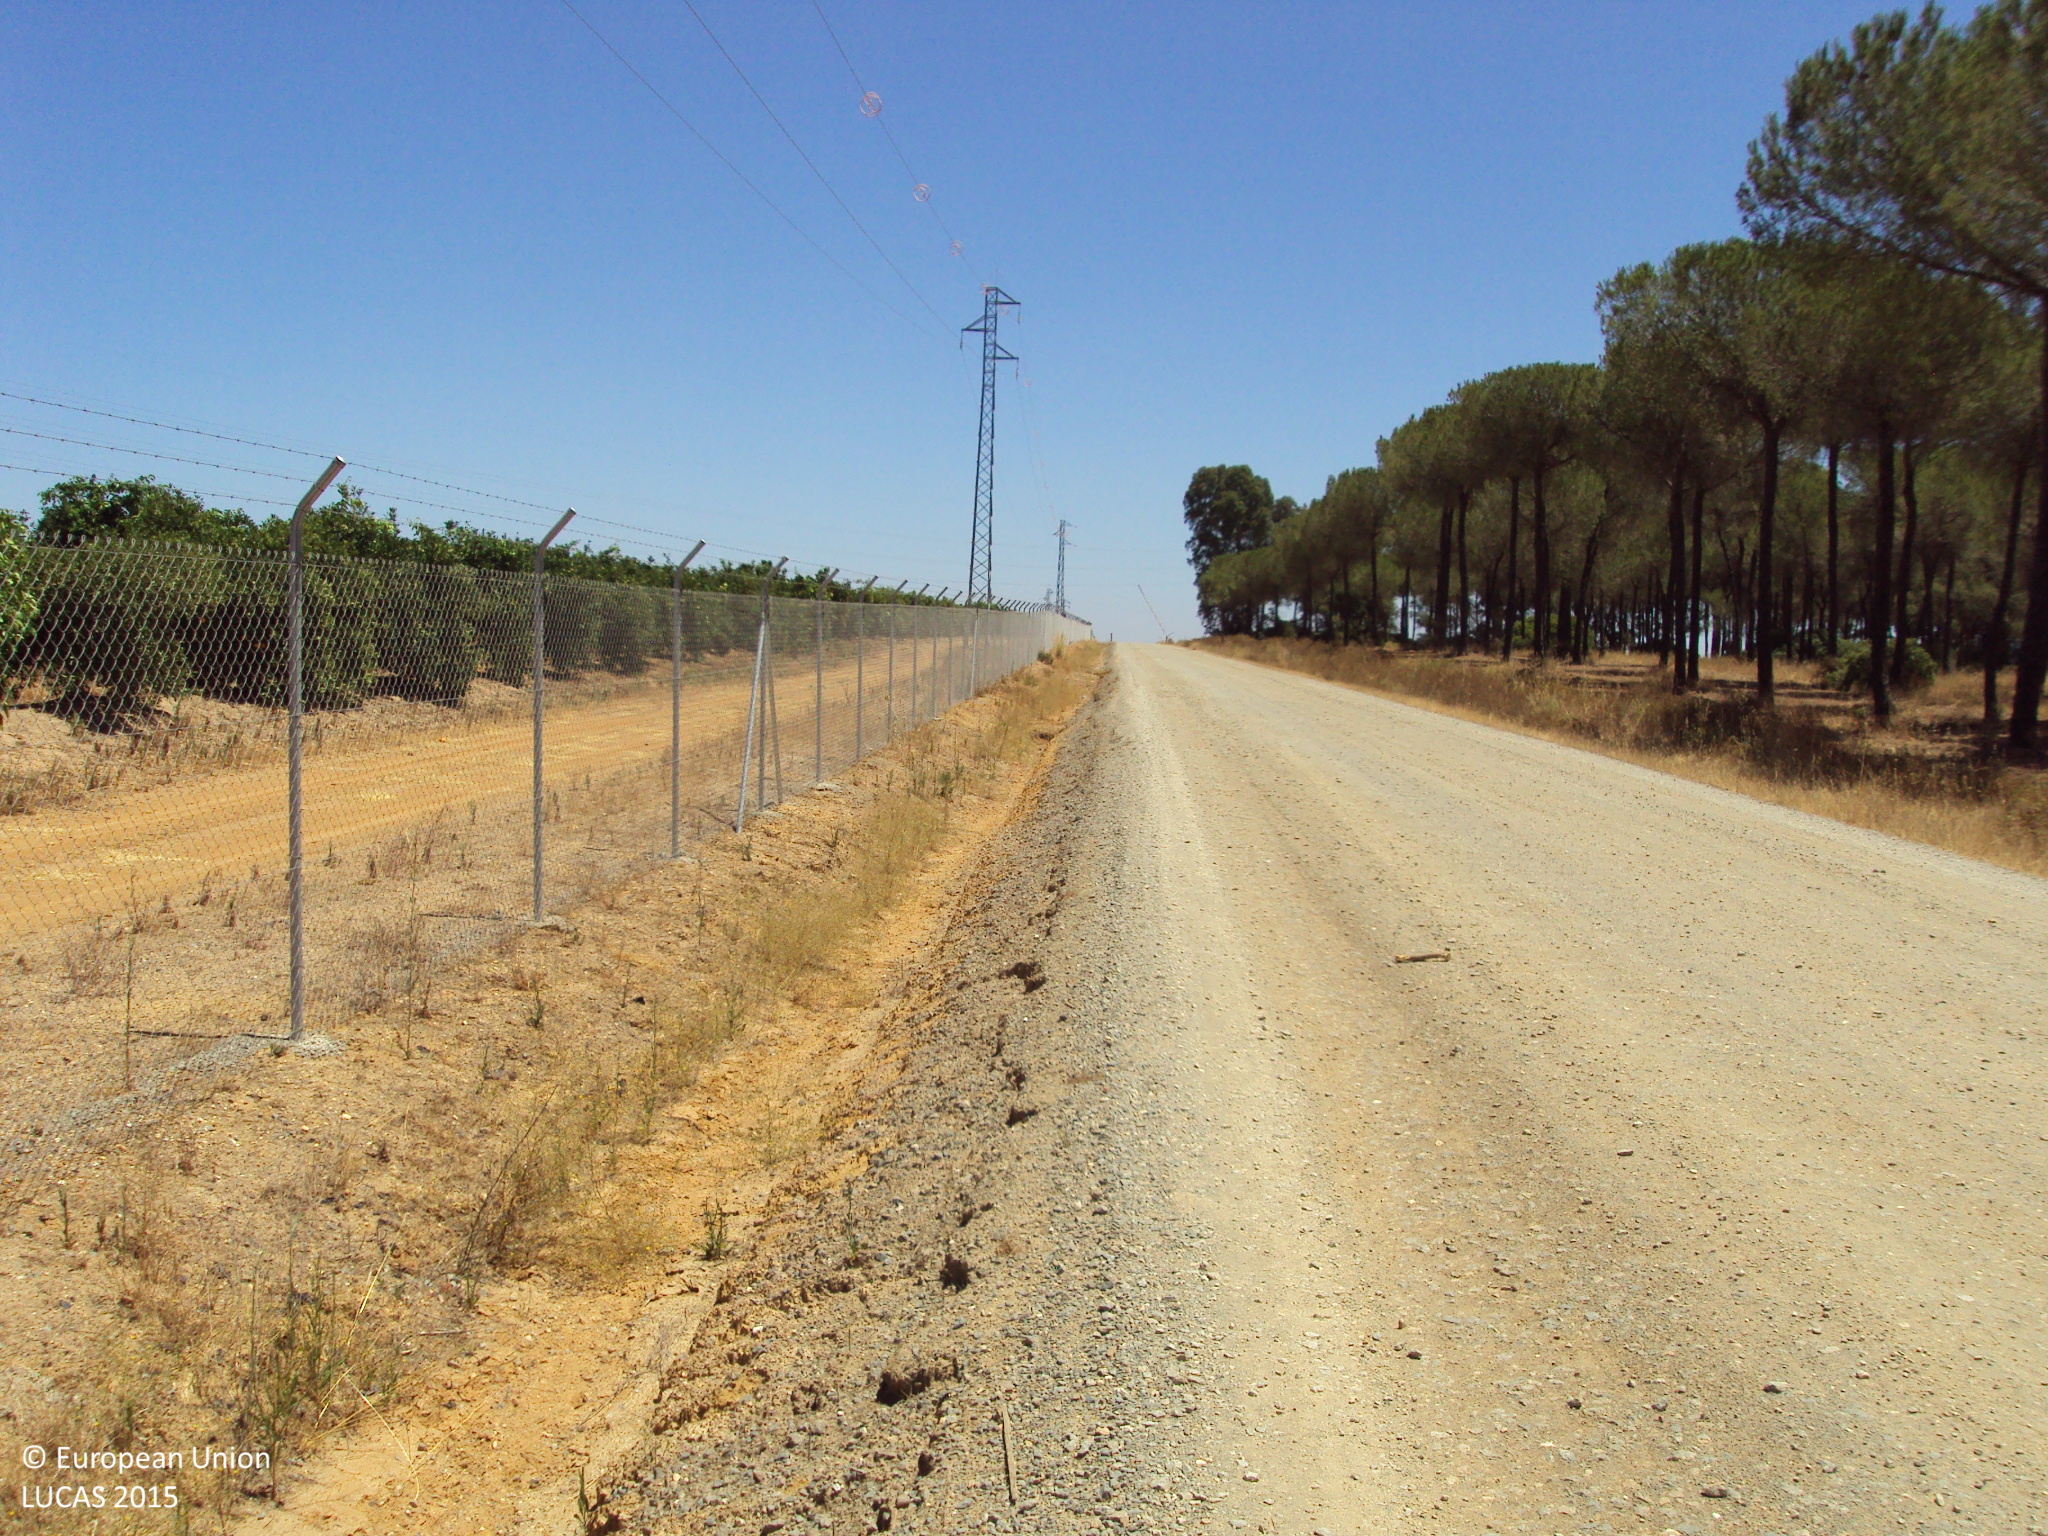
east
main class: Cropland
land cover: Oranges
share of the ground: > 75 %
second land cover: Spontaneously vegetated surfaces
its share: 10 - 25 %
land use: Agriculture (excluding fallow land and kitchen gardens)
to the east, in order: Oranges; Spontaneously vegetated surfaces
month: July
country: ES
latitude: 37.1934
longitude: -6.3269
